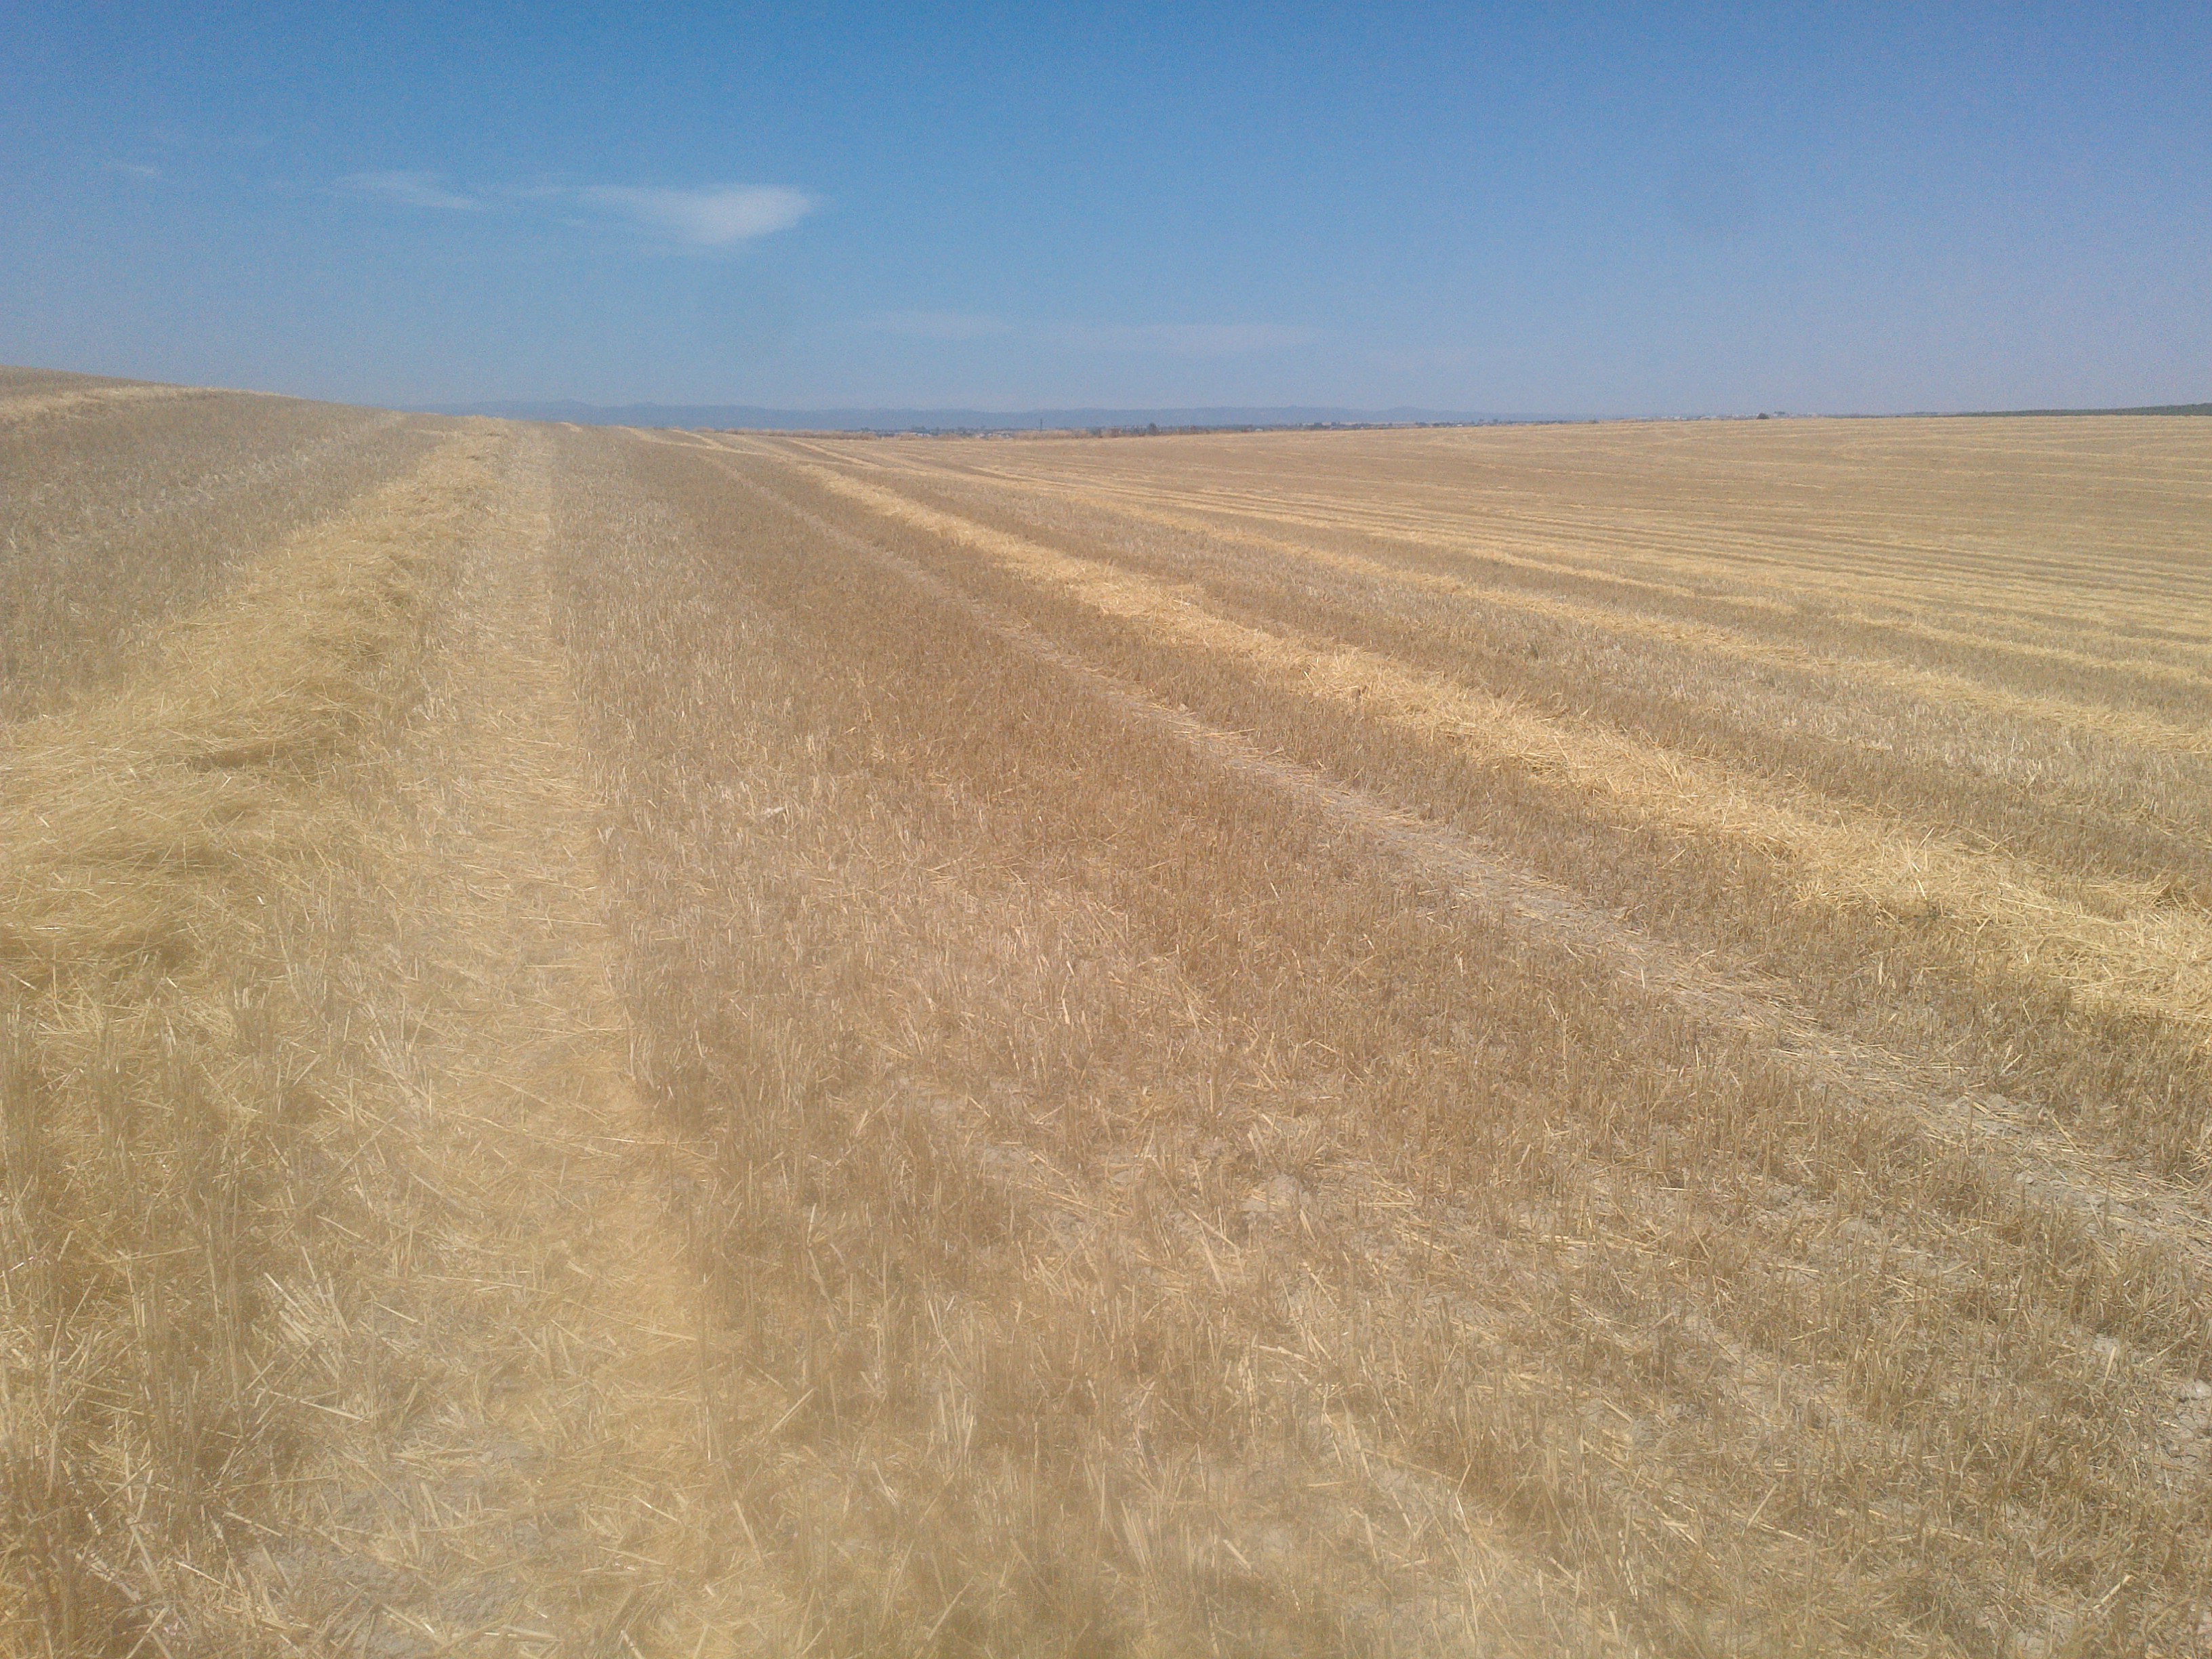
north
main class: Cropland
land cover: Durum wheat
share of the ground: < 10 %
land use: Agriculture (excluding fallow land and kitchen gardens)
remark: Harvested field
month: June
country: ES
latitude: 37.6104
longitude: -4.9311
